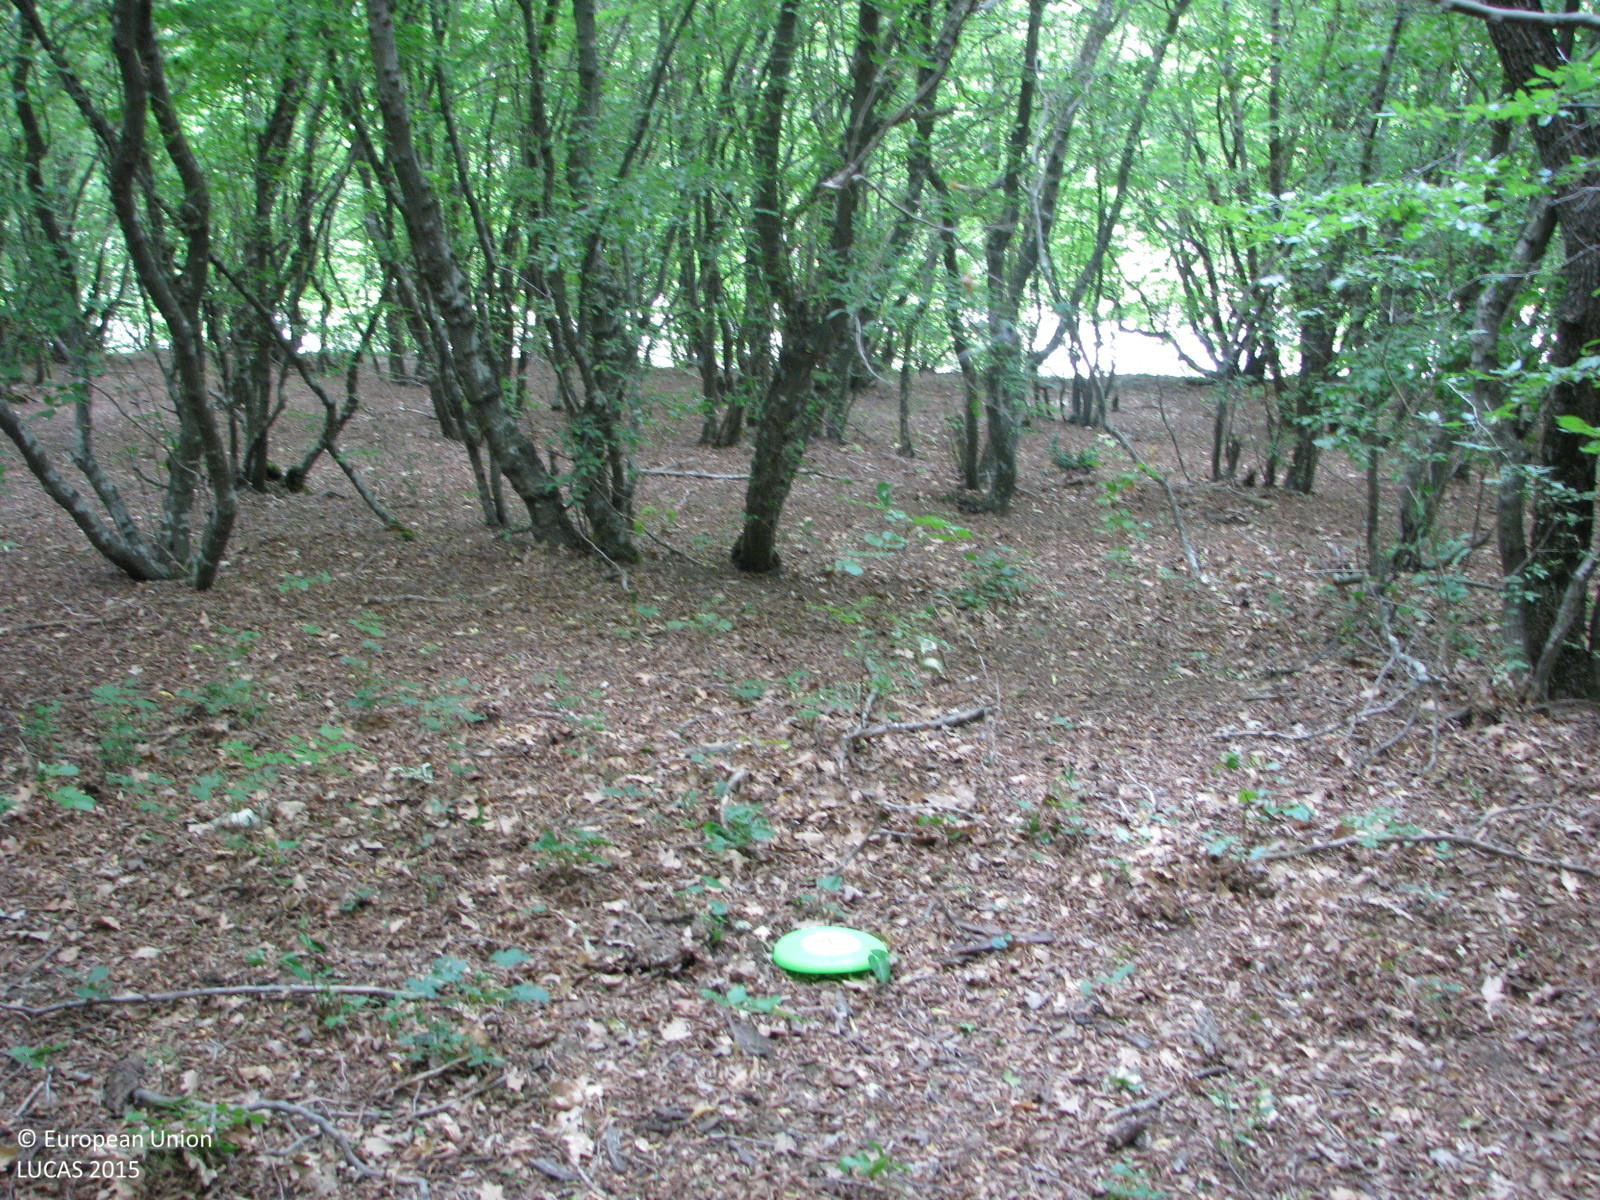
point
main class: Woodland
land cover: Broadleaved woodland
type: thermophilous deciduous forest
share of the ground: > 75 %
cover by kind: broadleaved forest trees 95 %, shrubs 5 %
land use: Forestry
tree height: > 5 m
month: June
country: BG
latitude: 42.6582
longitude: 26.6775
